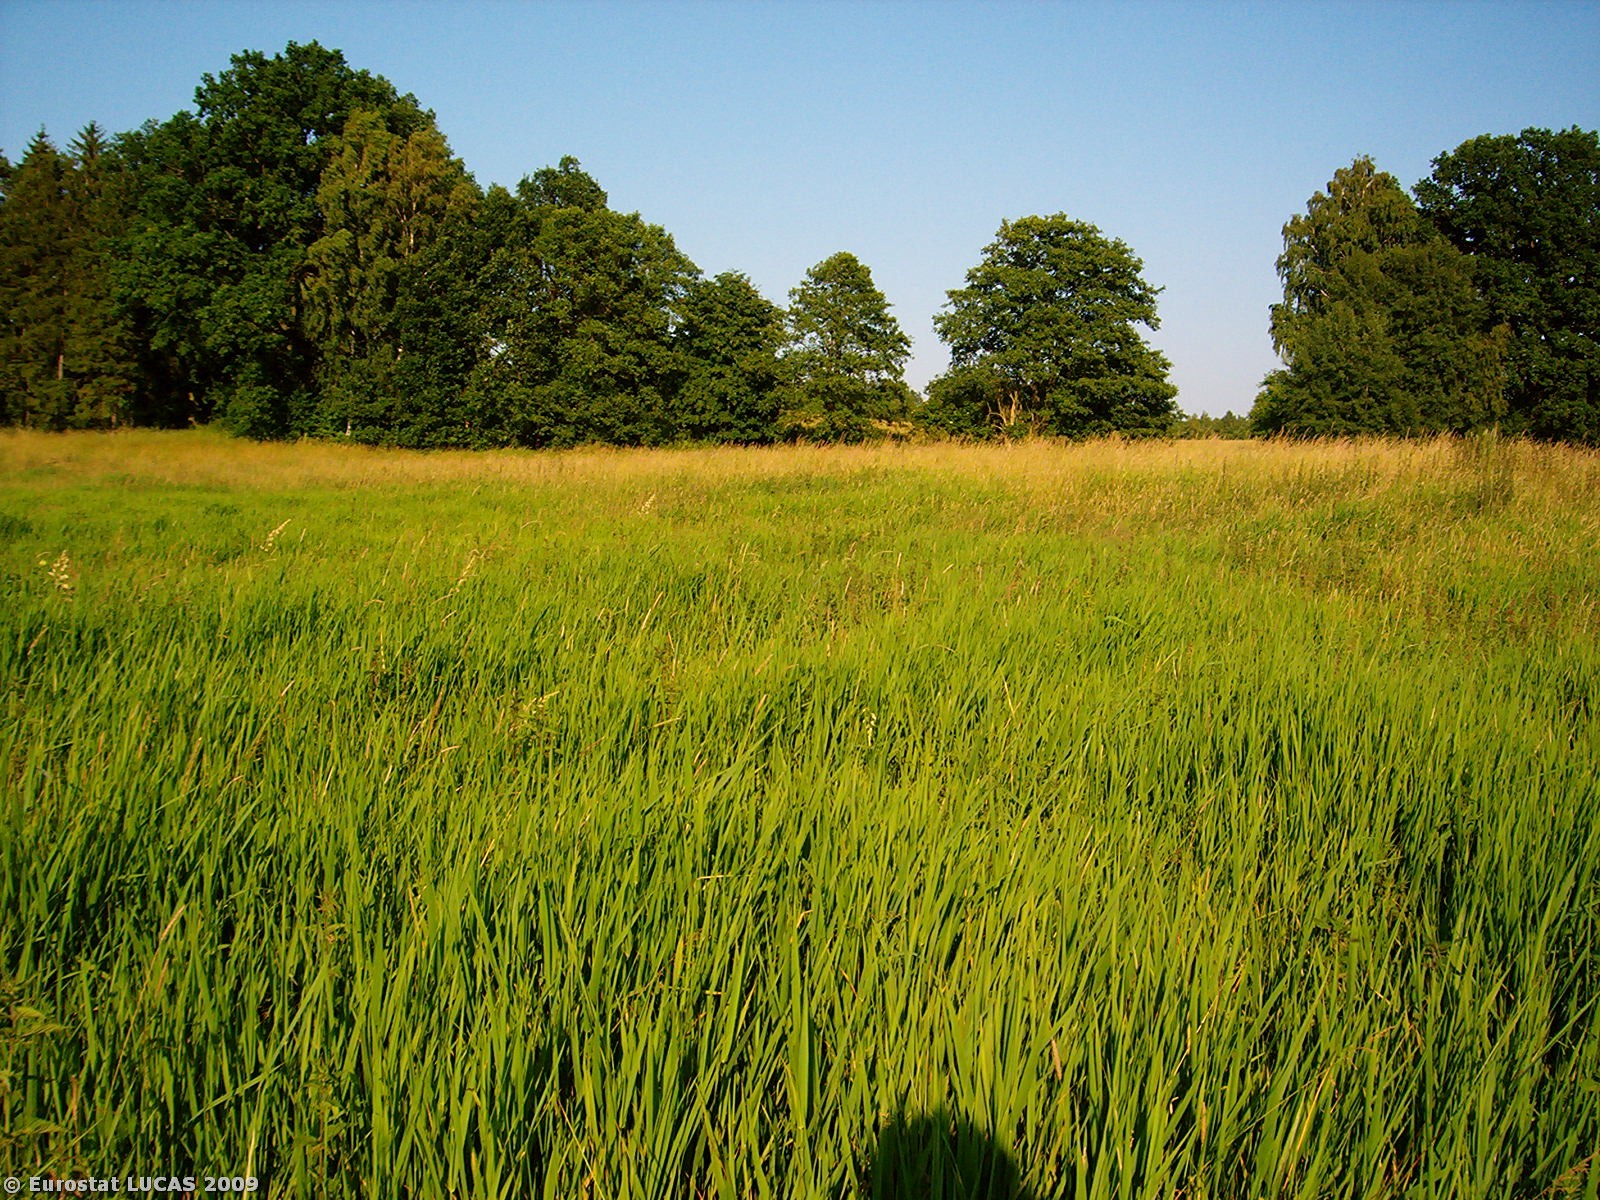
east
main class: Grassland
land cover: Grassland without tree/shrub cover
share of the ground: > 75 %
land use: Agriculture (excluding fallow land and kitchen gardens)
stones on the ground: < 10 %
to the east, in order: Grassland without tree/shrub cover; Broadleaved woodland; Triticale
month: July
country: PL
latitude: 53.6444
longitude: 15.3426
